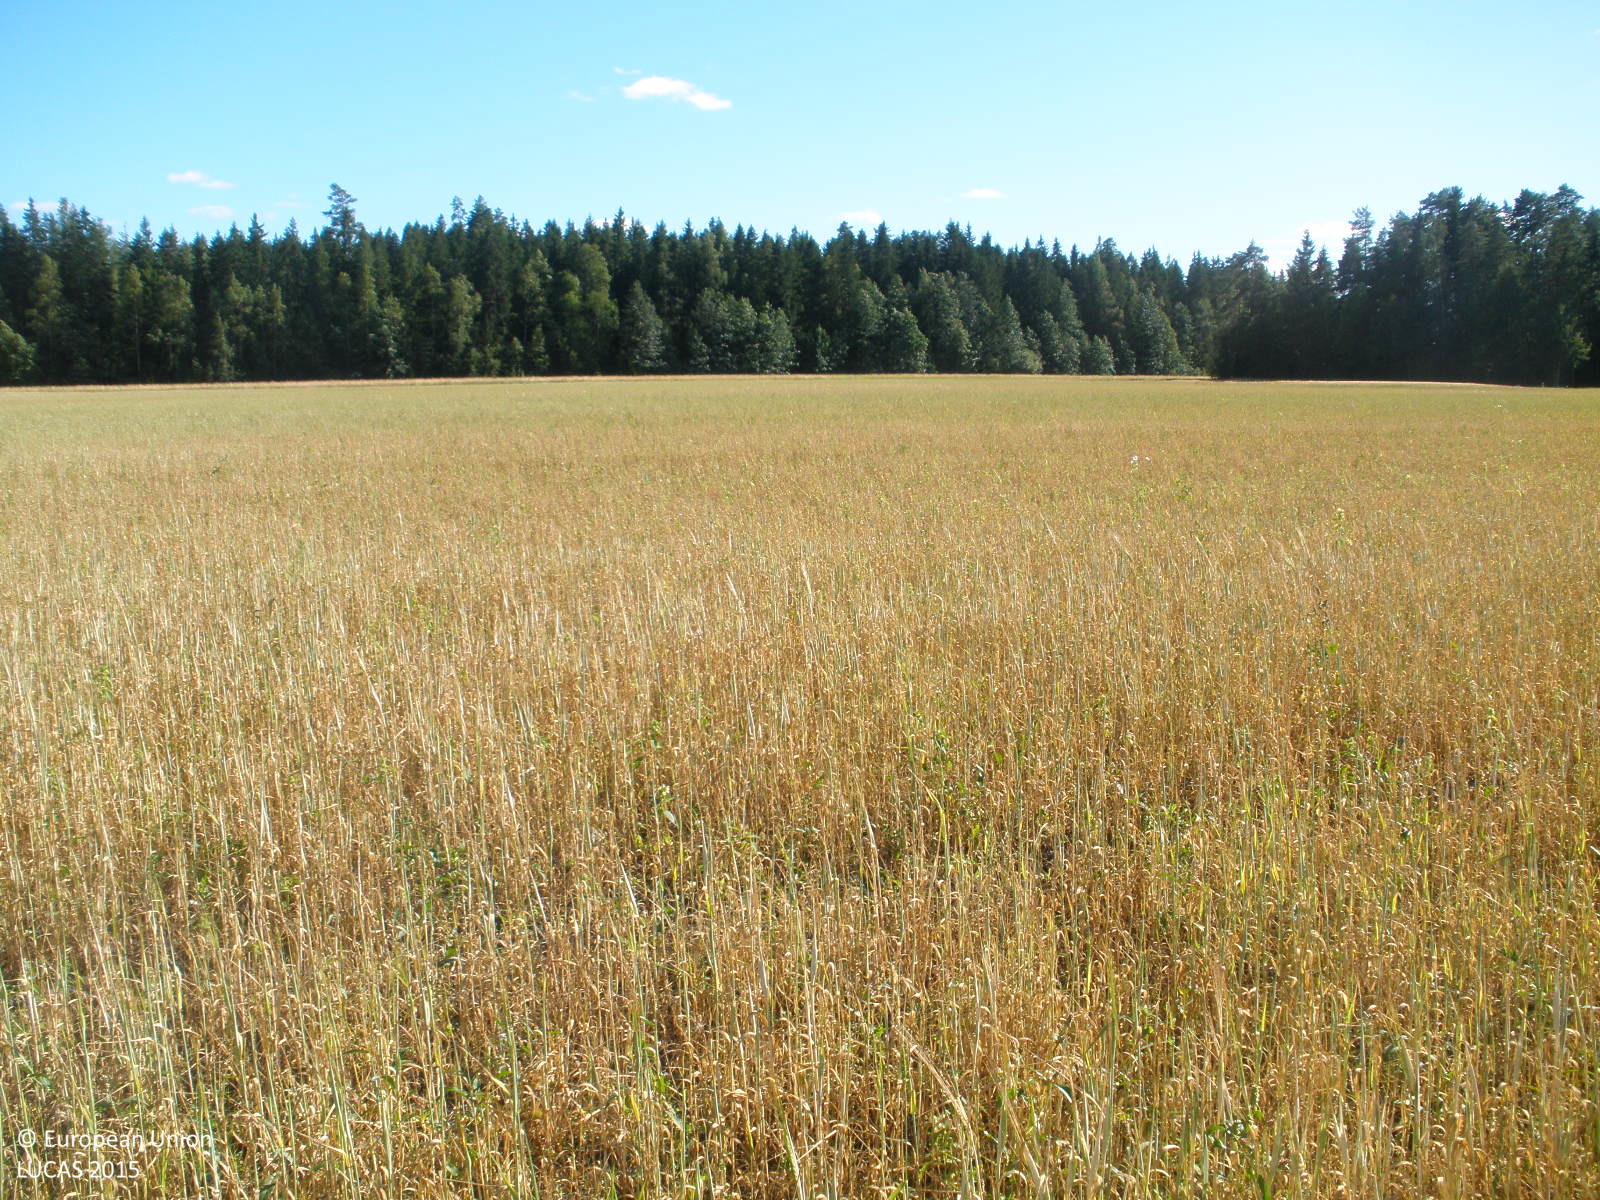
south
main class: Cropland
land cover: Barley
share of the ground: 50 - 75 %
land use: Agriculture (excluding fallow land and kitchen gardens)
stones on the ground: < 10 %
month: August
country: FI
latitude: 60.5498
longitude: 23.3392
